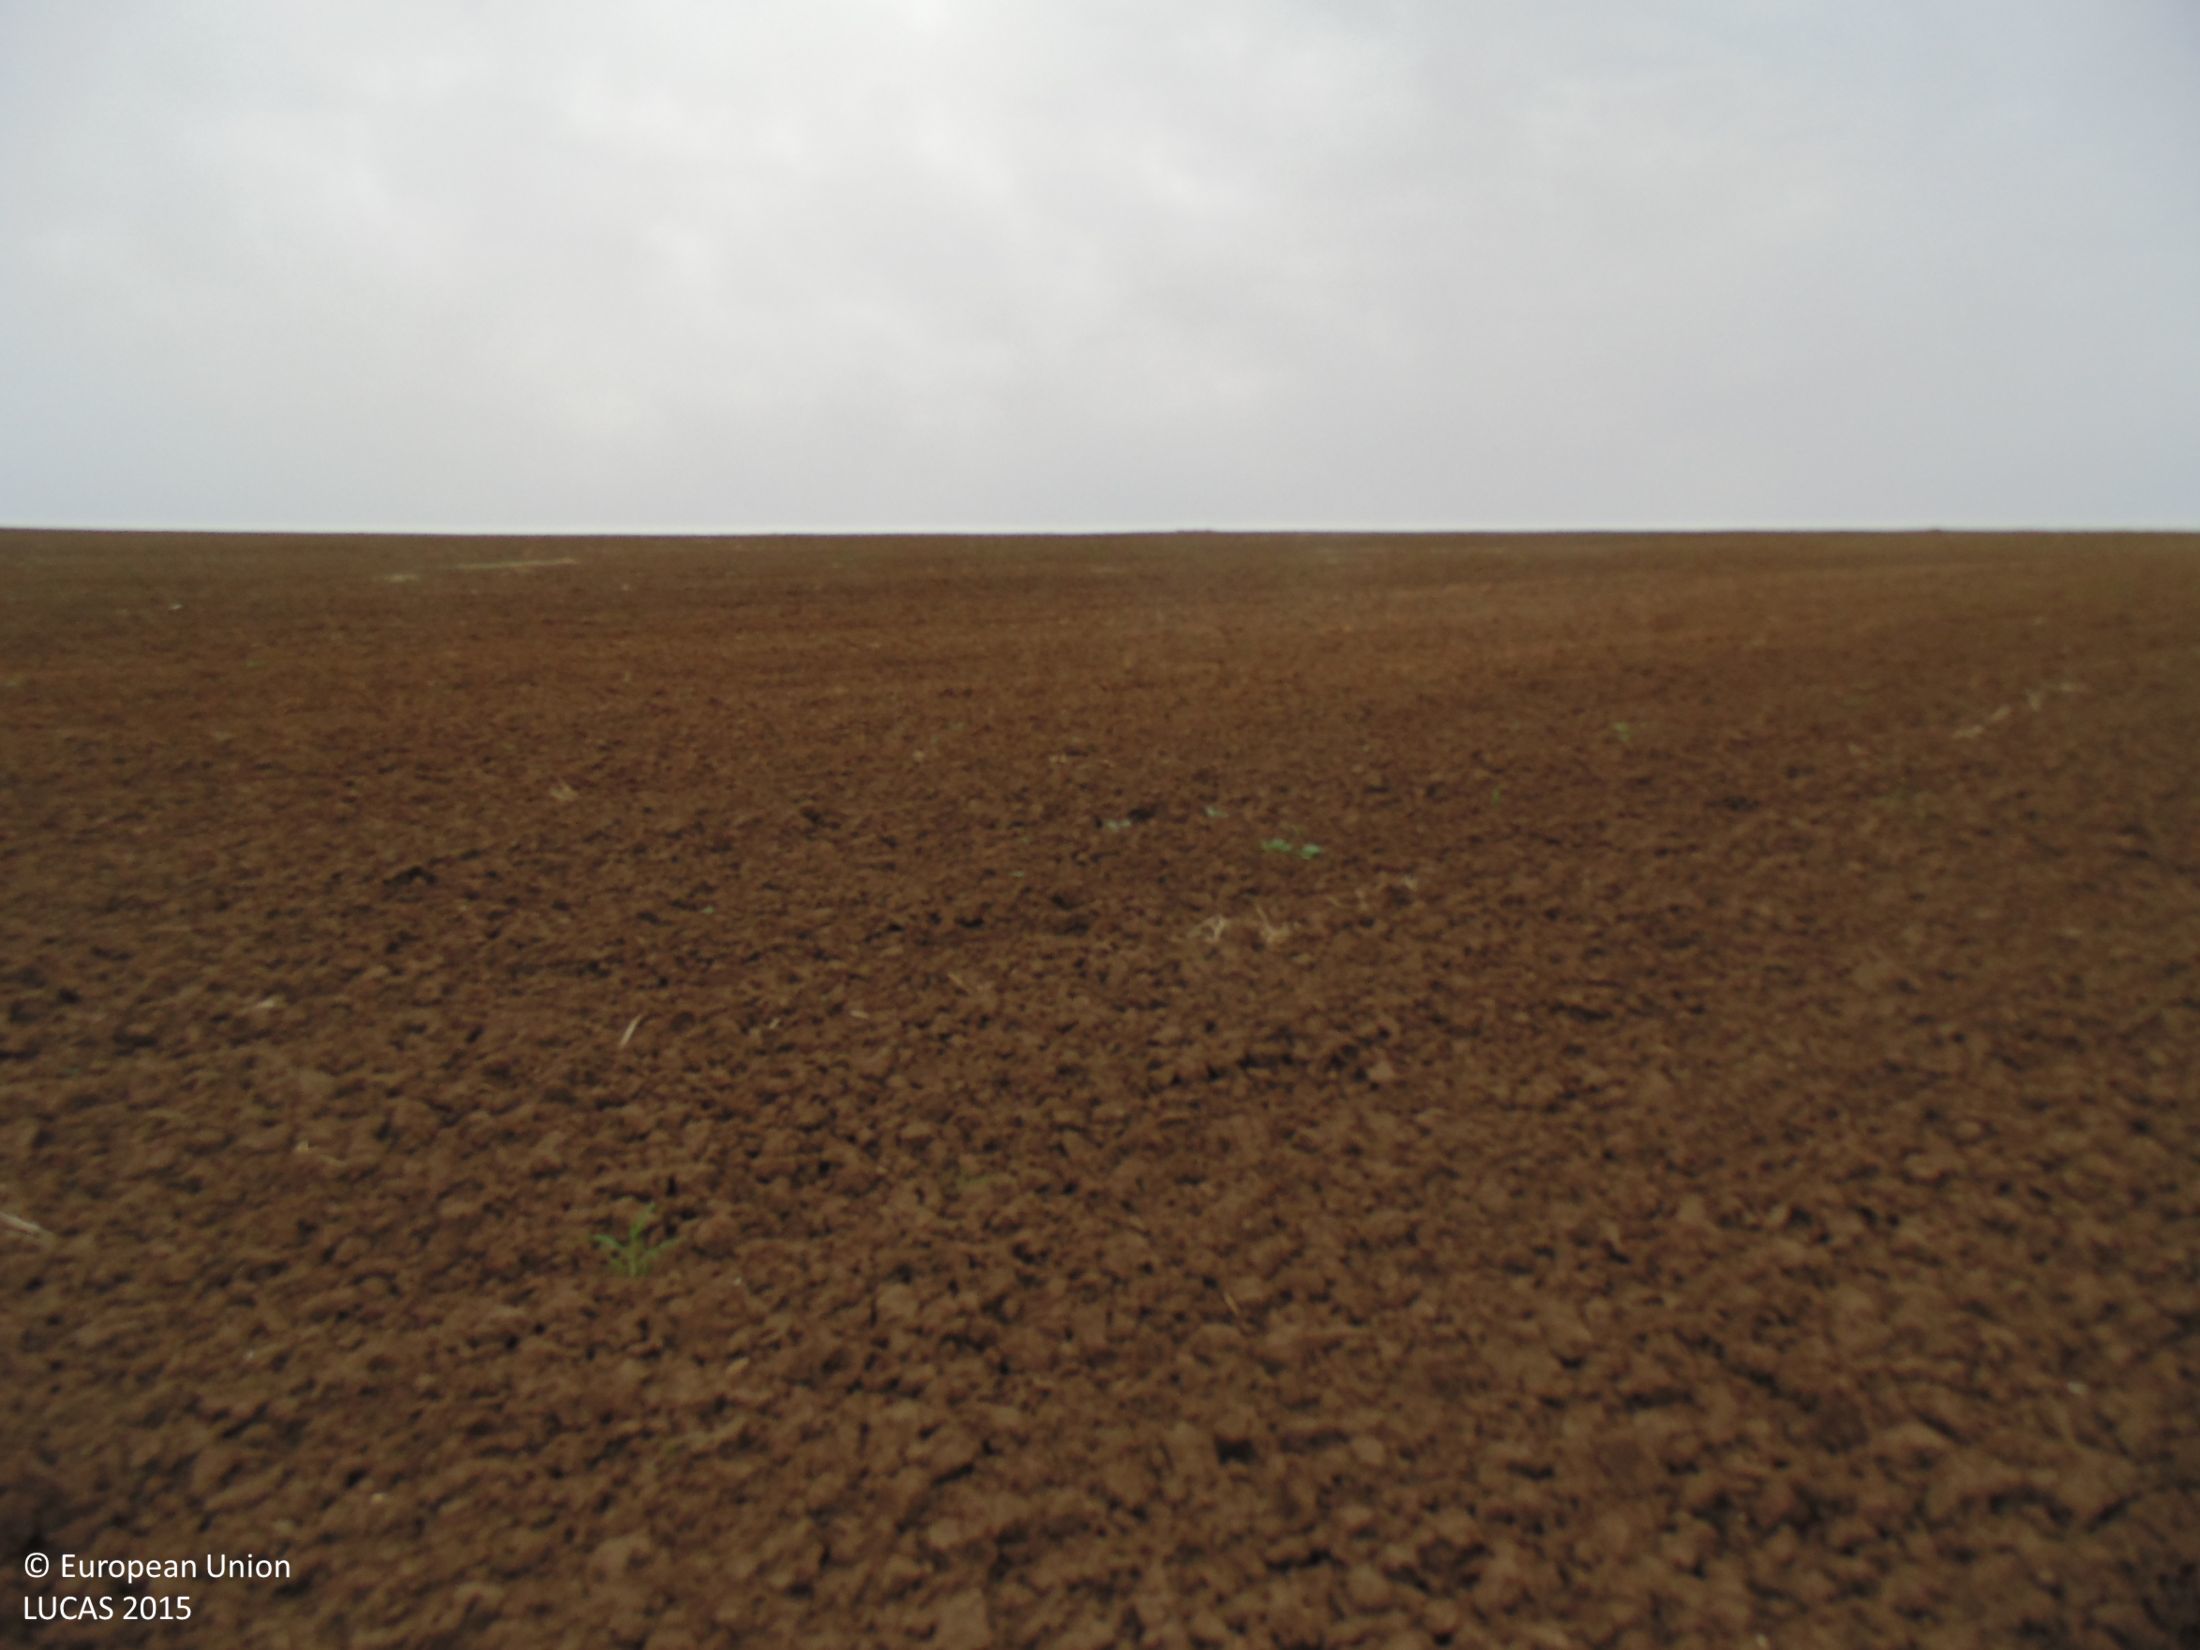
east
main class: Cropland
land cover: Common wheat
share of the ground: < 10 %
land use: Agriculture (excluding fallow land and kitchen gardens)
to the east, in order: Common wheat
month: September
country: BG
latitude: 44.0258
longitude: 27.0810
